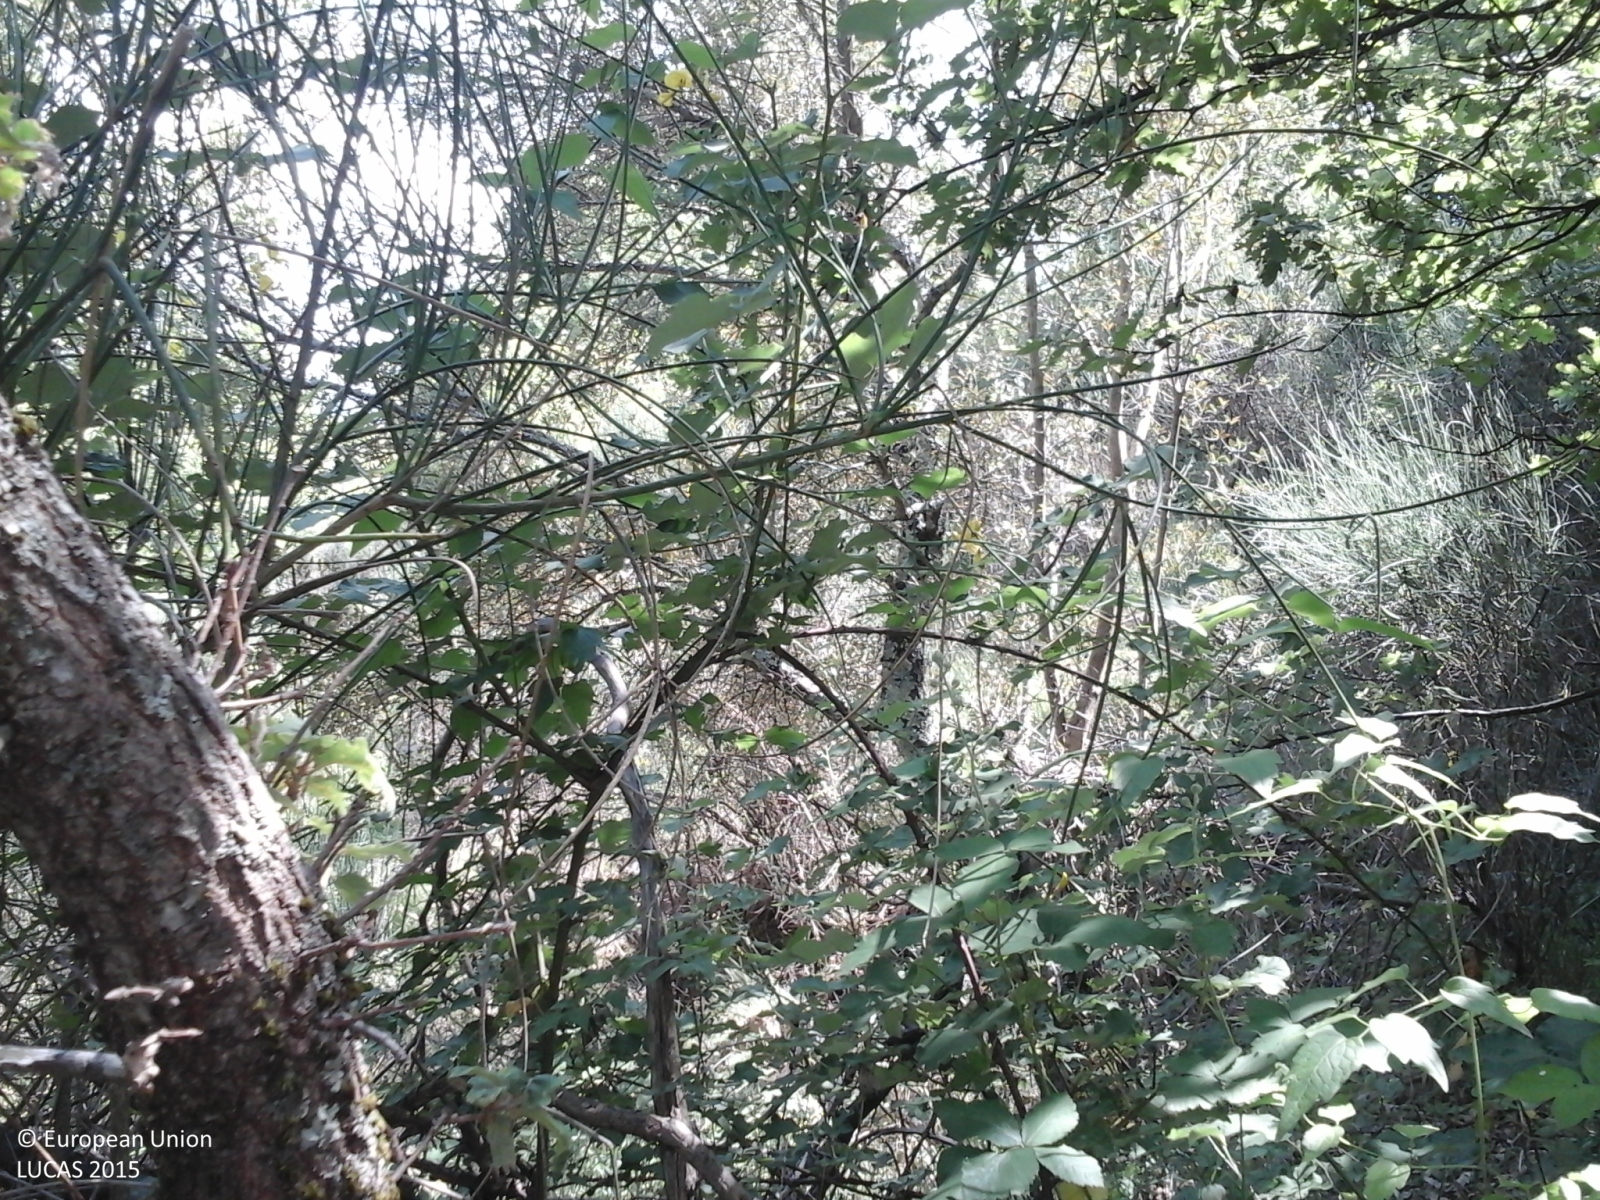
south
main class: Shrubland
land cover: Shrubland with sparse tree cover
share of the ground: > 75 %
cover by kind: shrubs 90 %, broadleaved forest trees 5 %, herbaceous plants 5 %
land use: Semi-natural and natural areas not in use
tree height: < 5 m
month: June
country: IT
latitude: 41.6281
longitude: 13.6953
